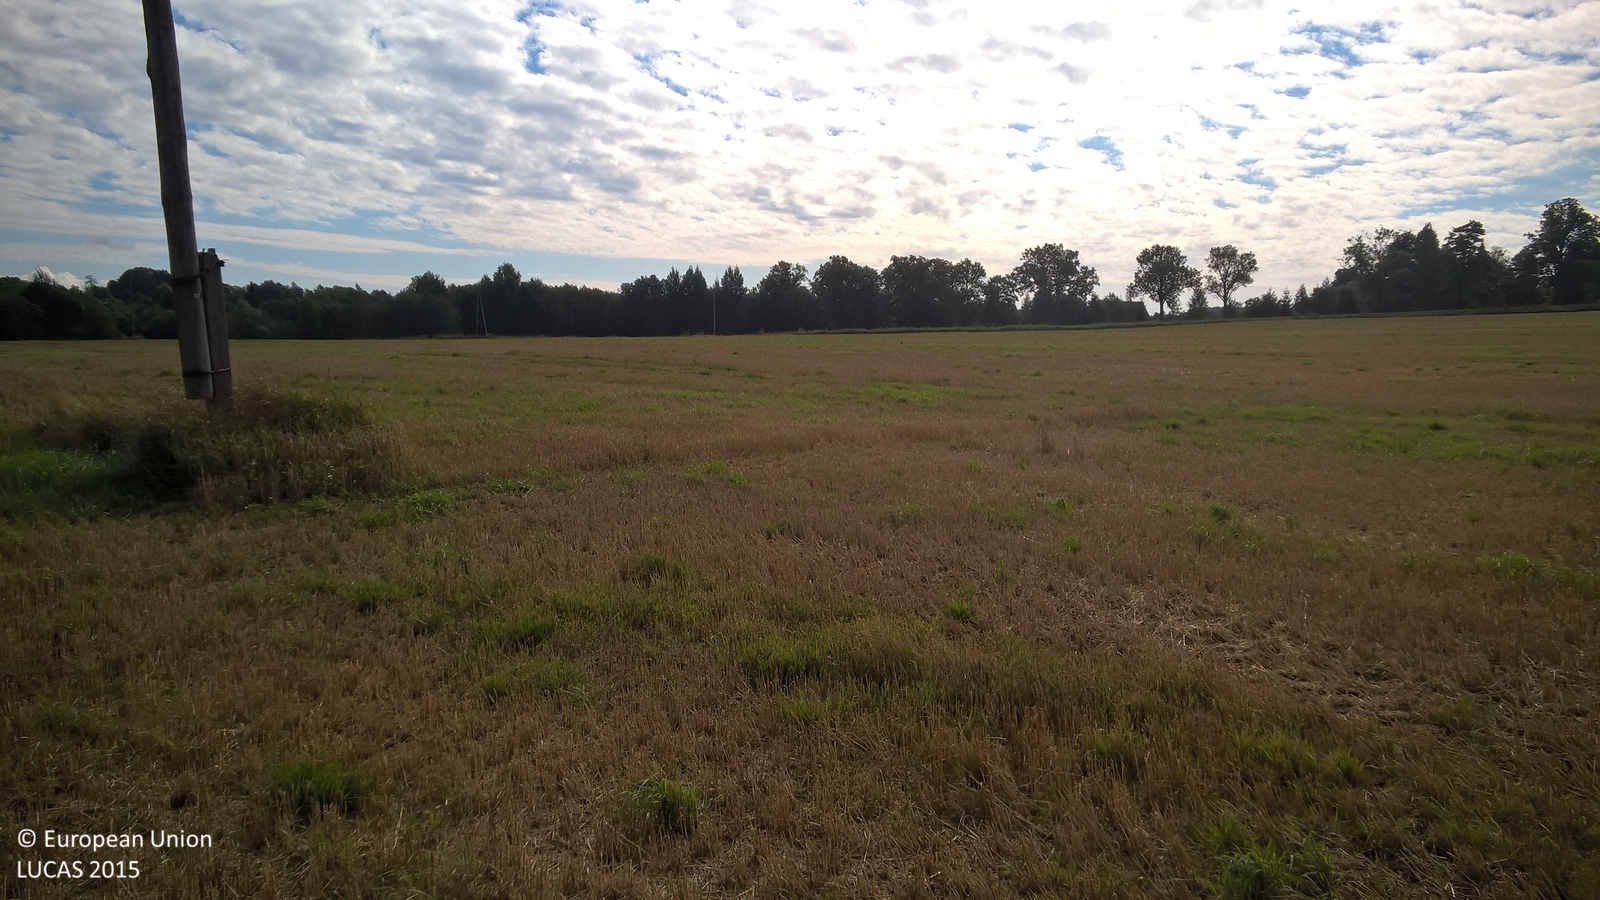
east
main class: Cropland
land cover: Barley
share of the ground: < 10 %
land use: Agriculture (excluding fallow land and kitchen gardens)
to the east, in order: Barley; Electric lines; Barley; Electric lines; Barley
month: September
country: LV
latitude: 57.3326
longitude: 25.4809
